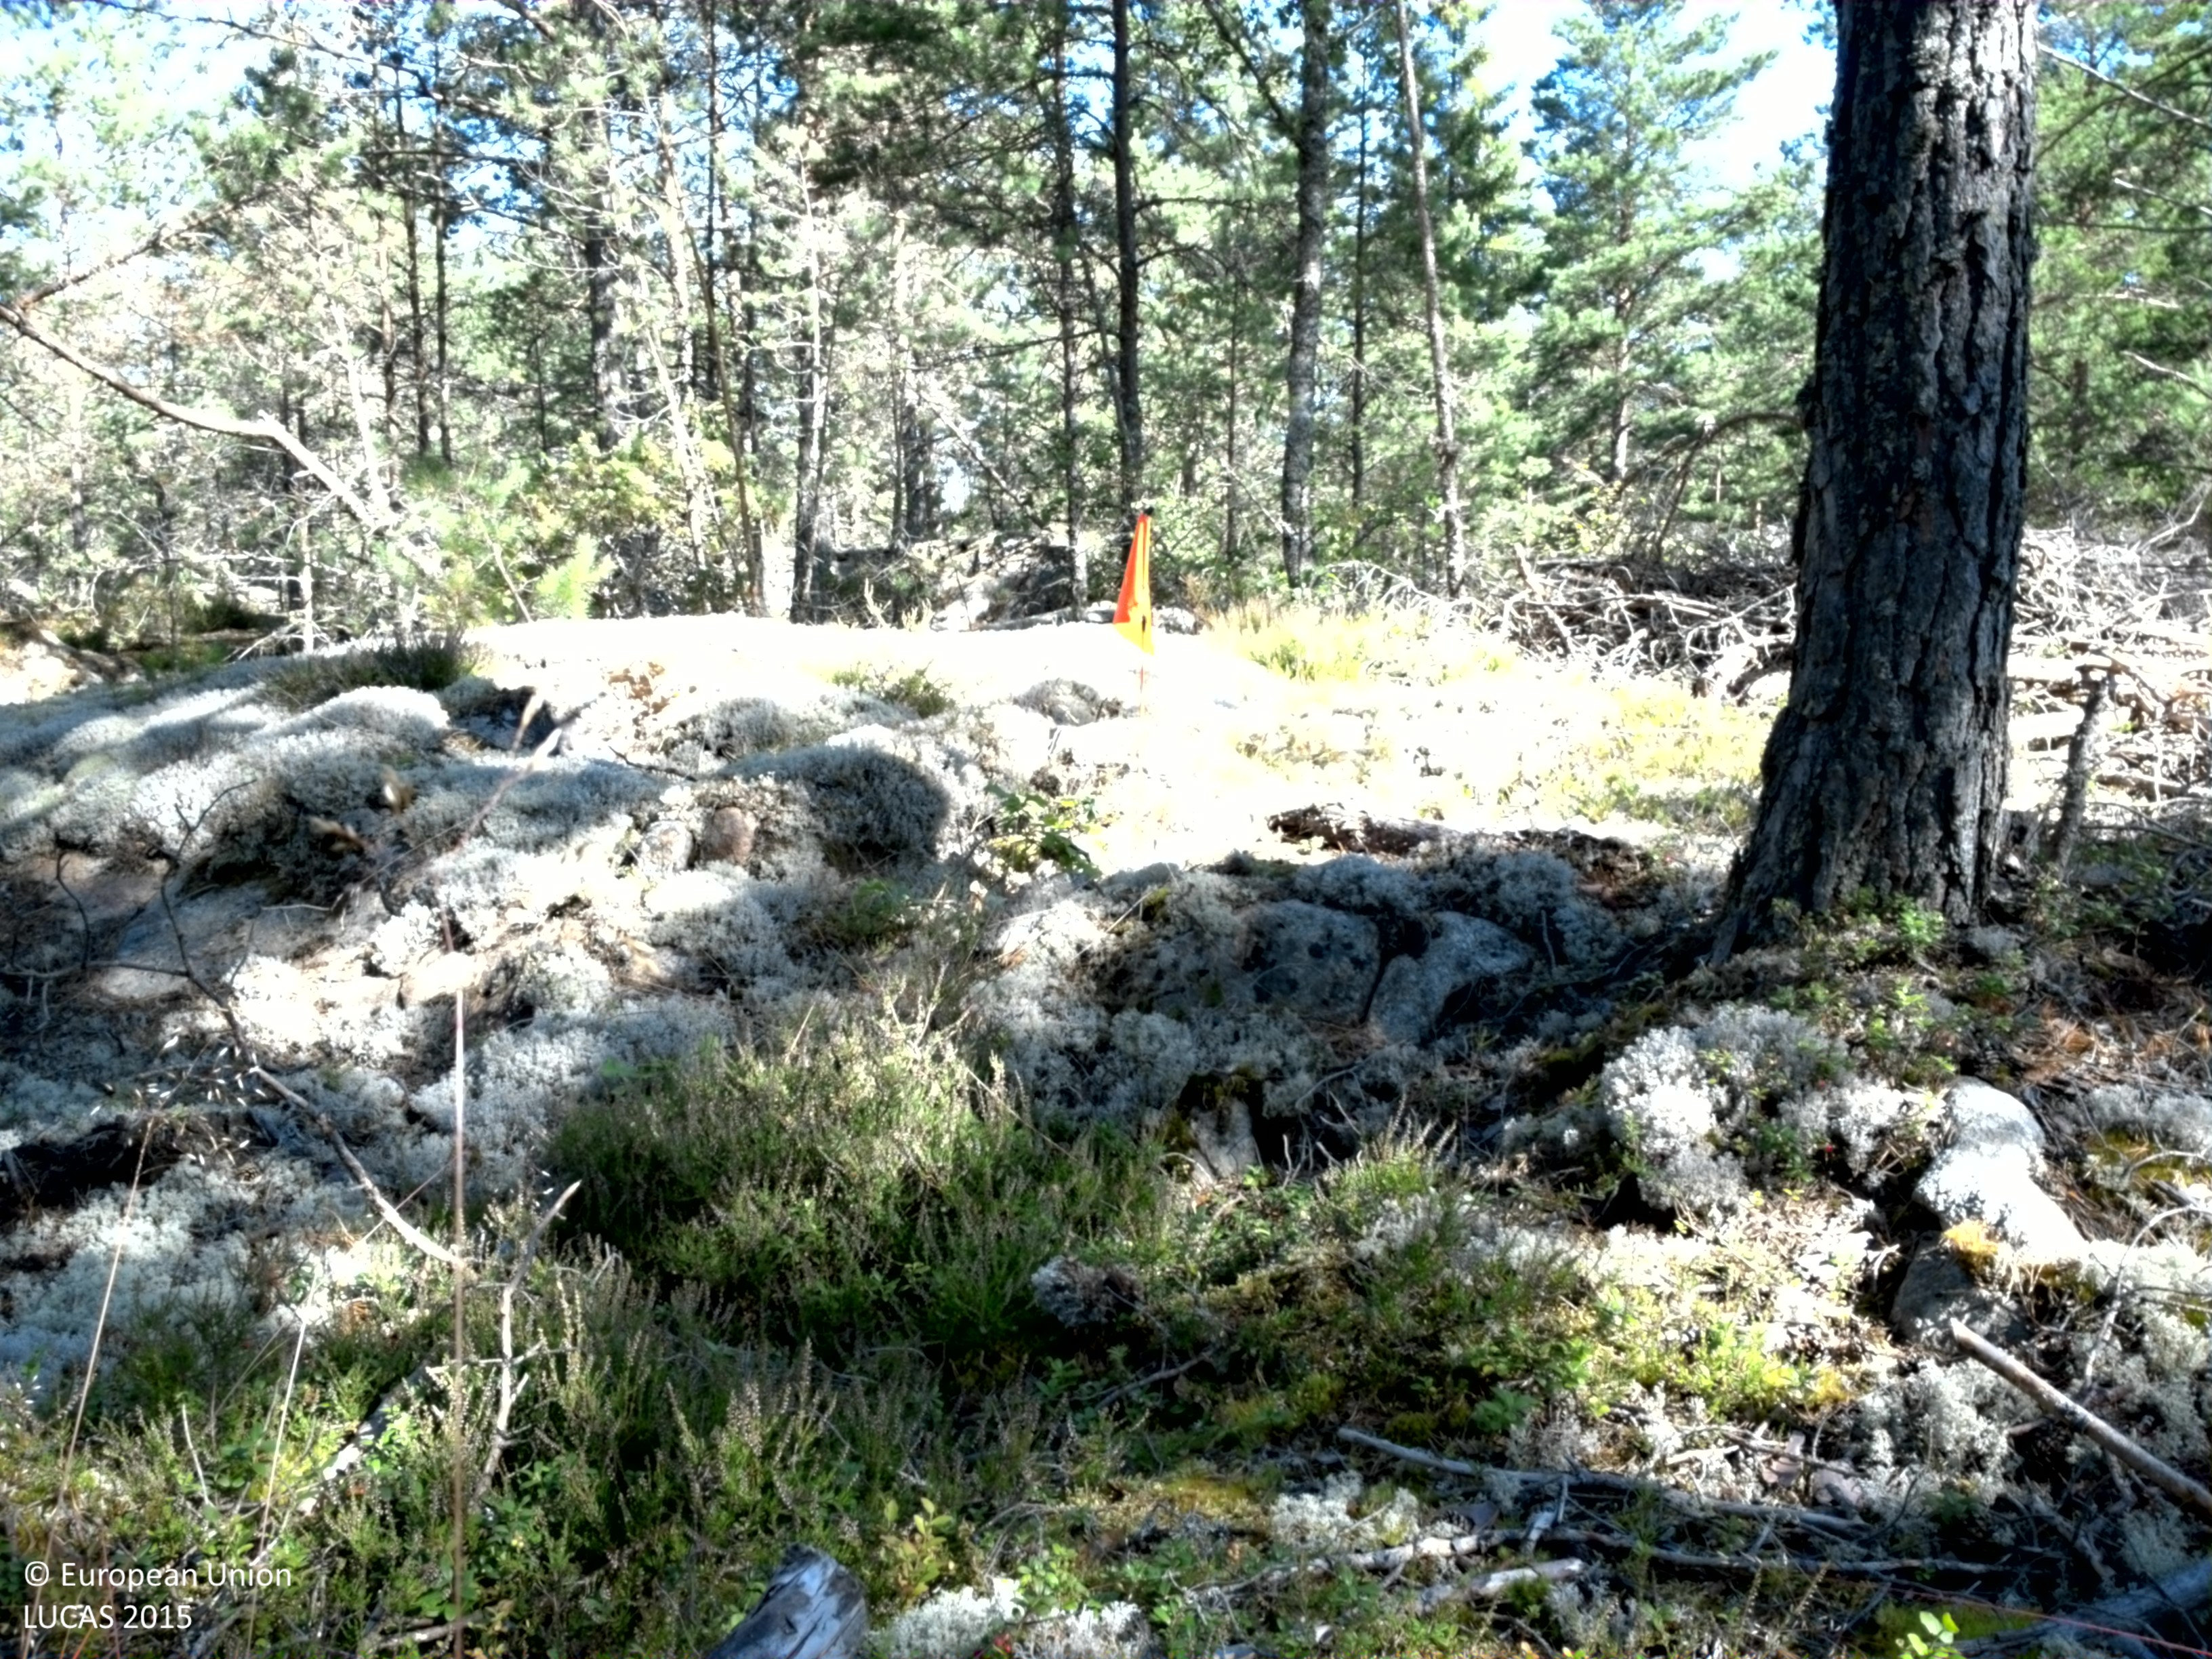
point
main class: Woodland
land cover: Pine dominated coniferous woodland
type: boreal forest
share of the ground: 25 - 50 %
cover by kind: lichens and mosses 45 %, coniferous forest trees 40 %, broadleaved forest trees 5 %, shrubs 5 %, consolidated bare surface 5 %
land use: Forestry
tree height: > 5 m
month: August
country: SE
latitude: 59.5587
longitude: 18.5468
